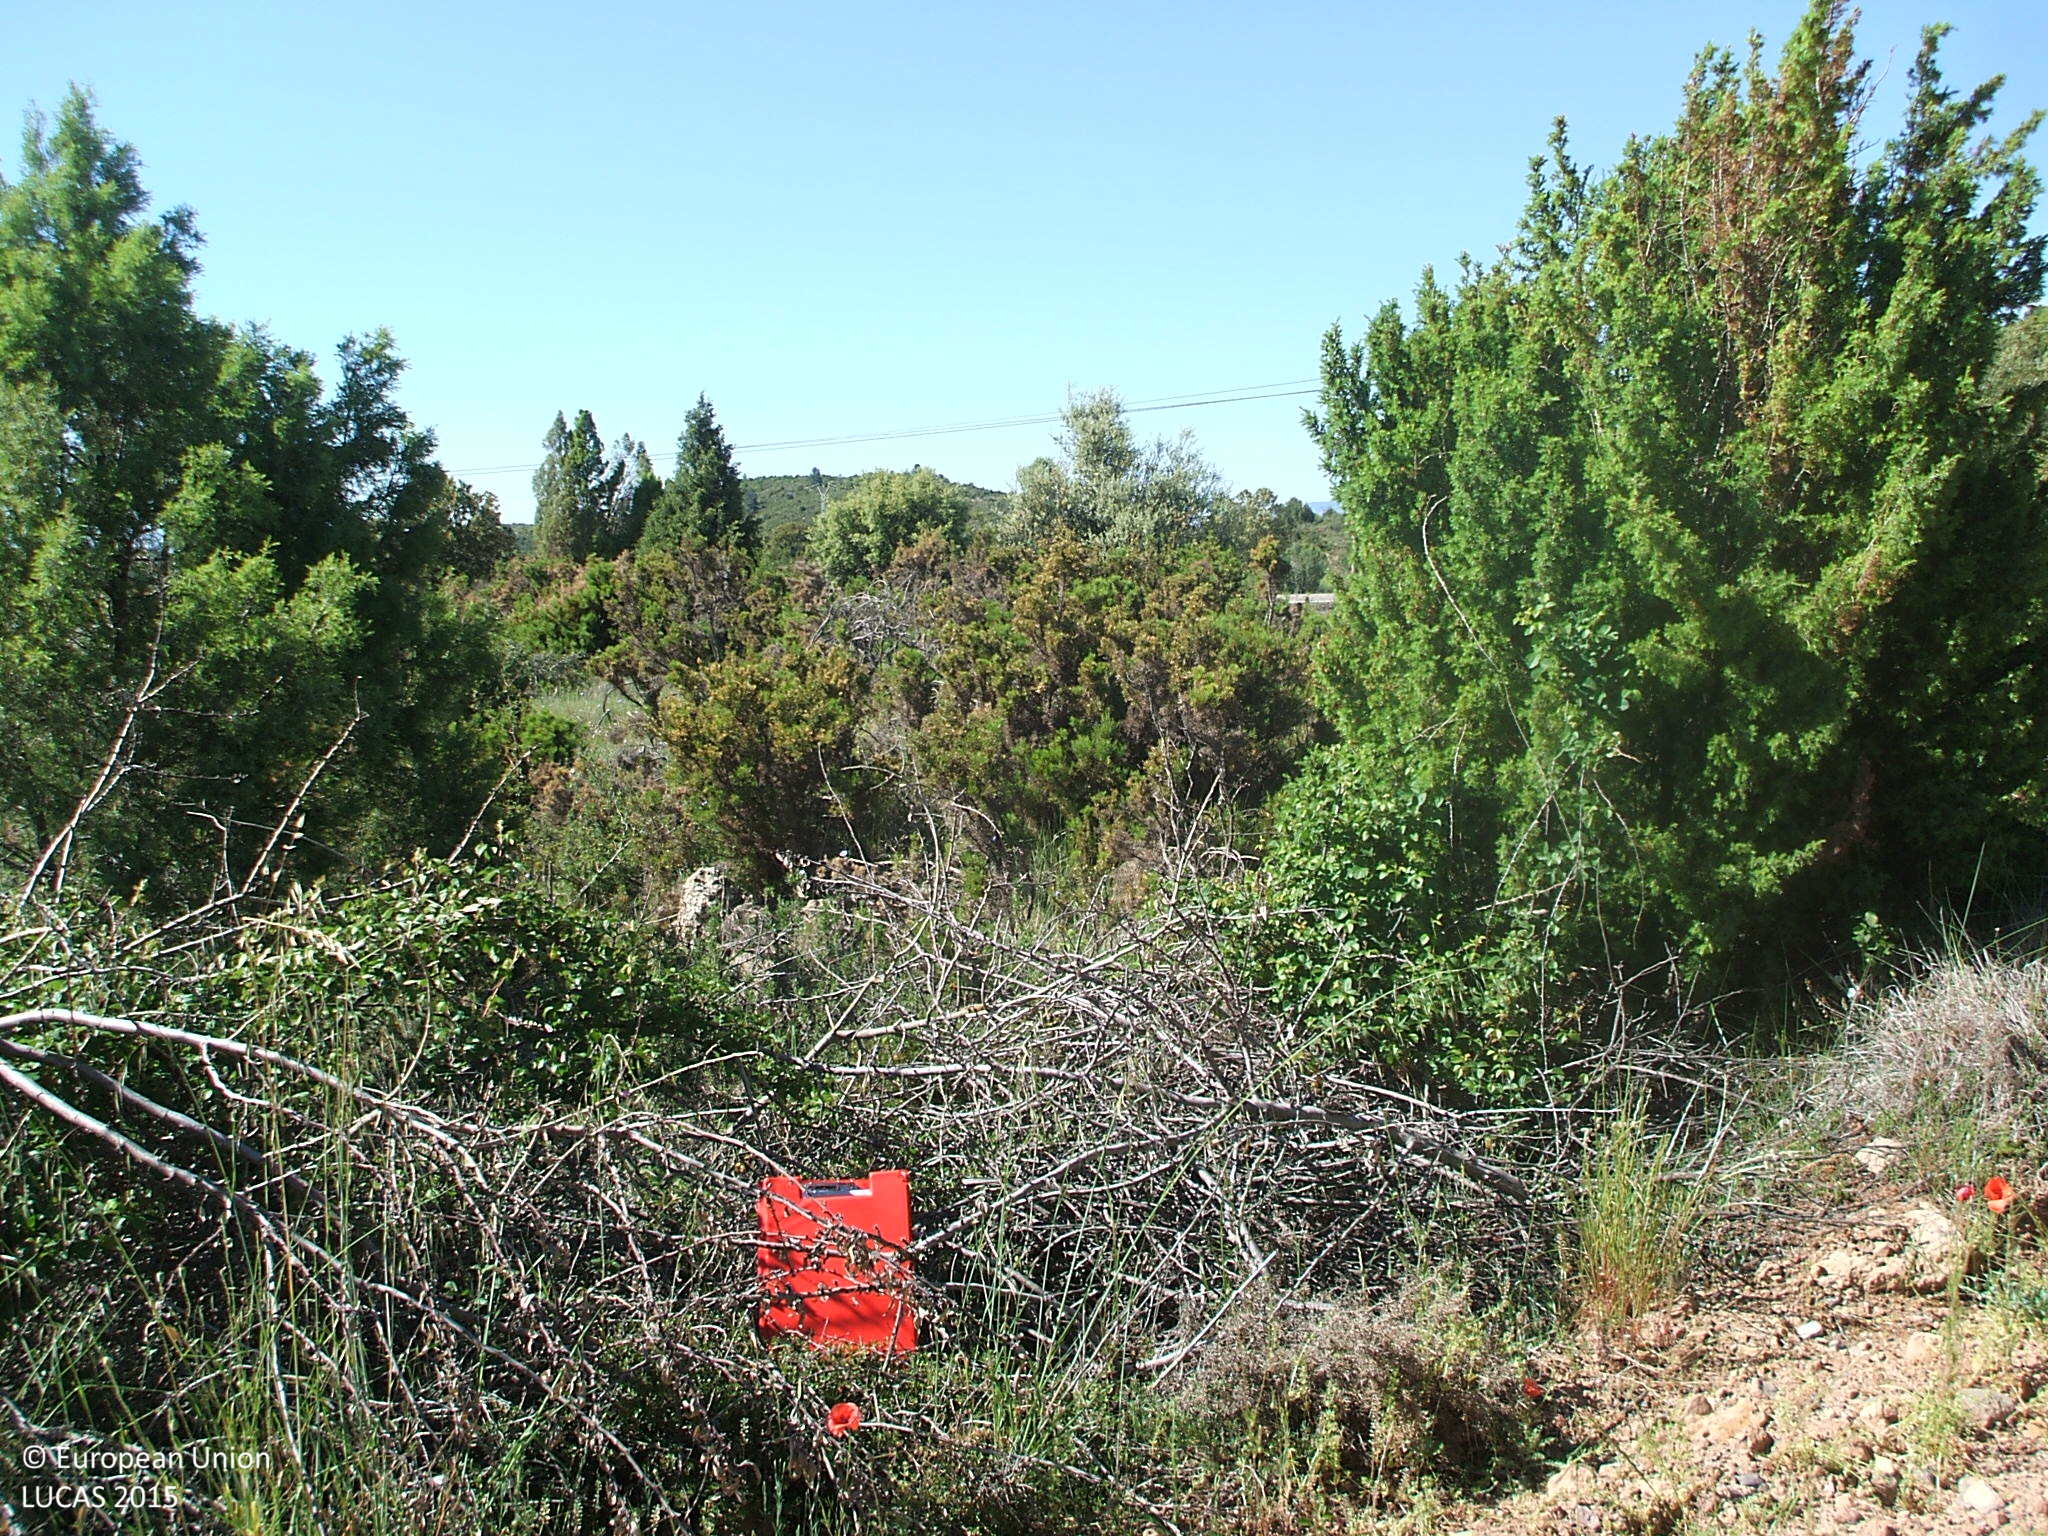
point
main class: Shrubland
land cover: Shrubland with sparse tree cover
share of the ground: 25 - 50 %
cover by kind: unconsolidated bare surface 40 %, shrubs 30 %, herbaceous plants 25 %, coniferous forest trees 5 %
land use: Semi-natural and natural areas not in use
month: May
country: ES
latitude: 40.0291
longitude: -0.6800
